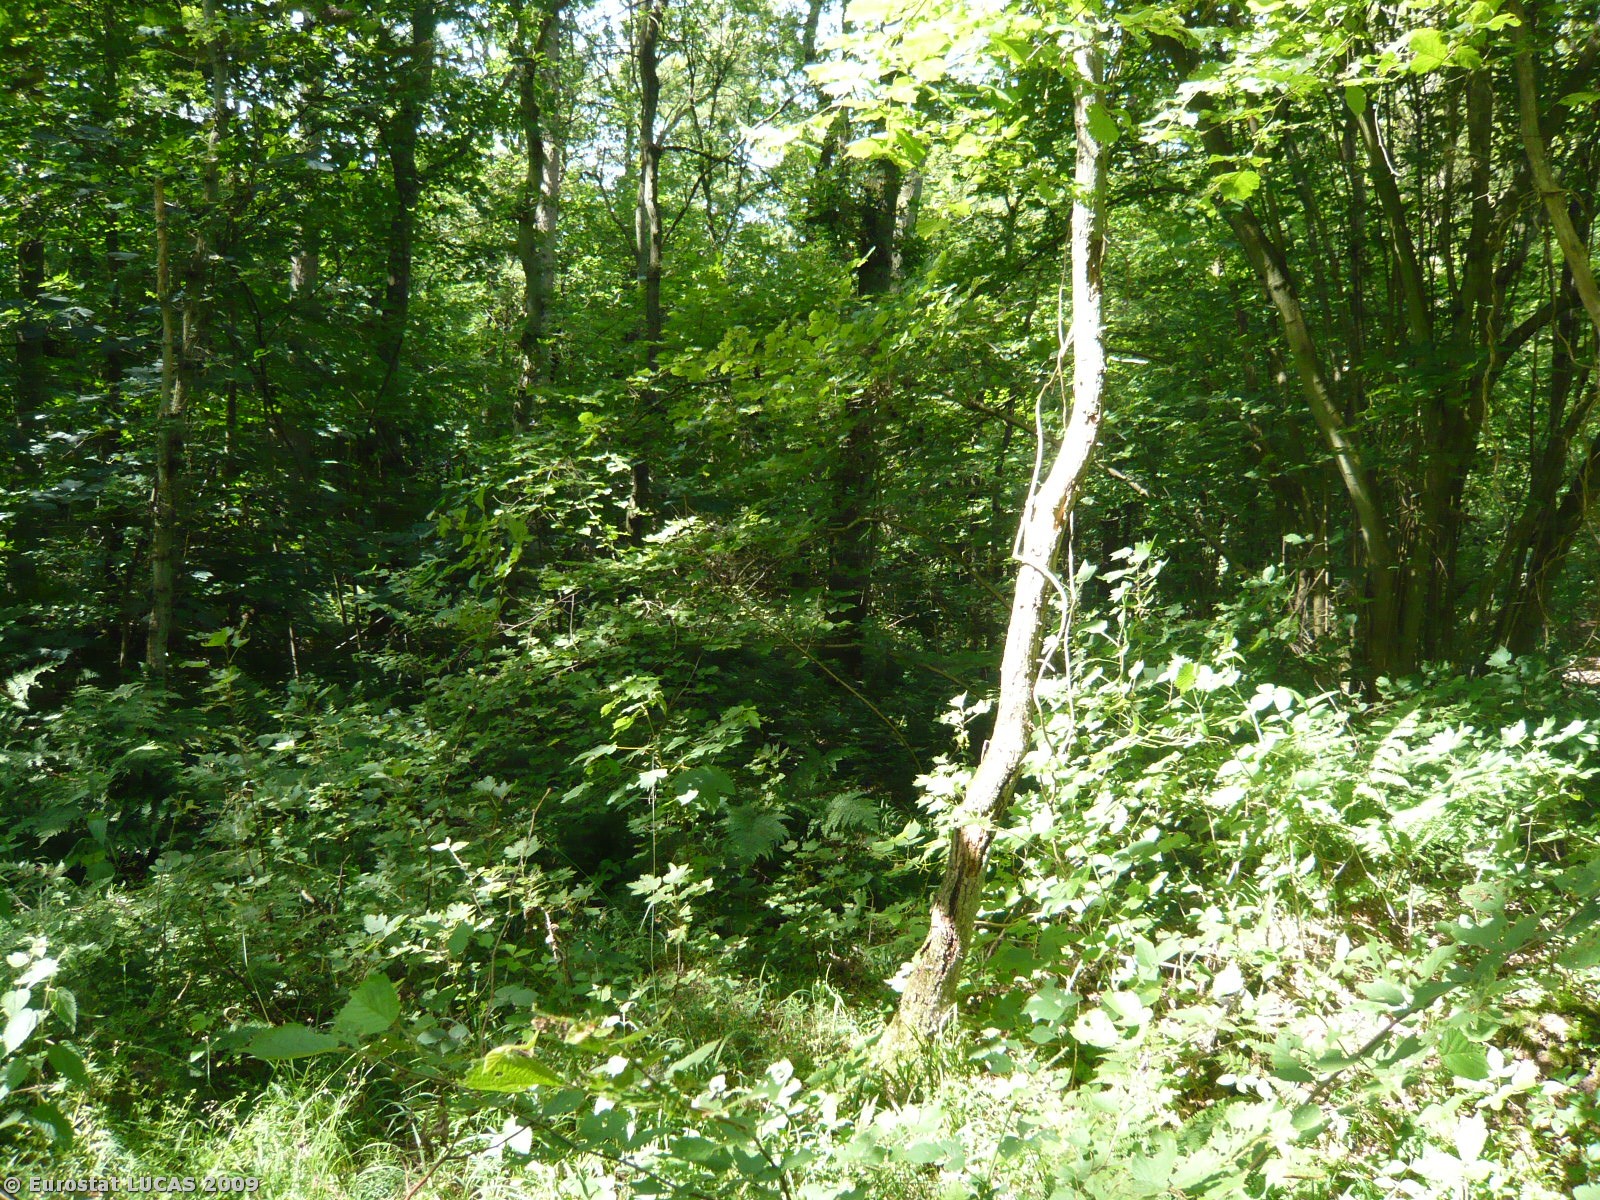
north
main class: Woodland
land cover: Broadleaved woodland
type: mesophytic deciduous forest
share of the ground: > 75 %
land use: Amenities, museums, leisure
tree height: > 5 m
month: June
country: DK
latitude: 55.1450
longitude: 10.2665
